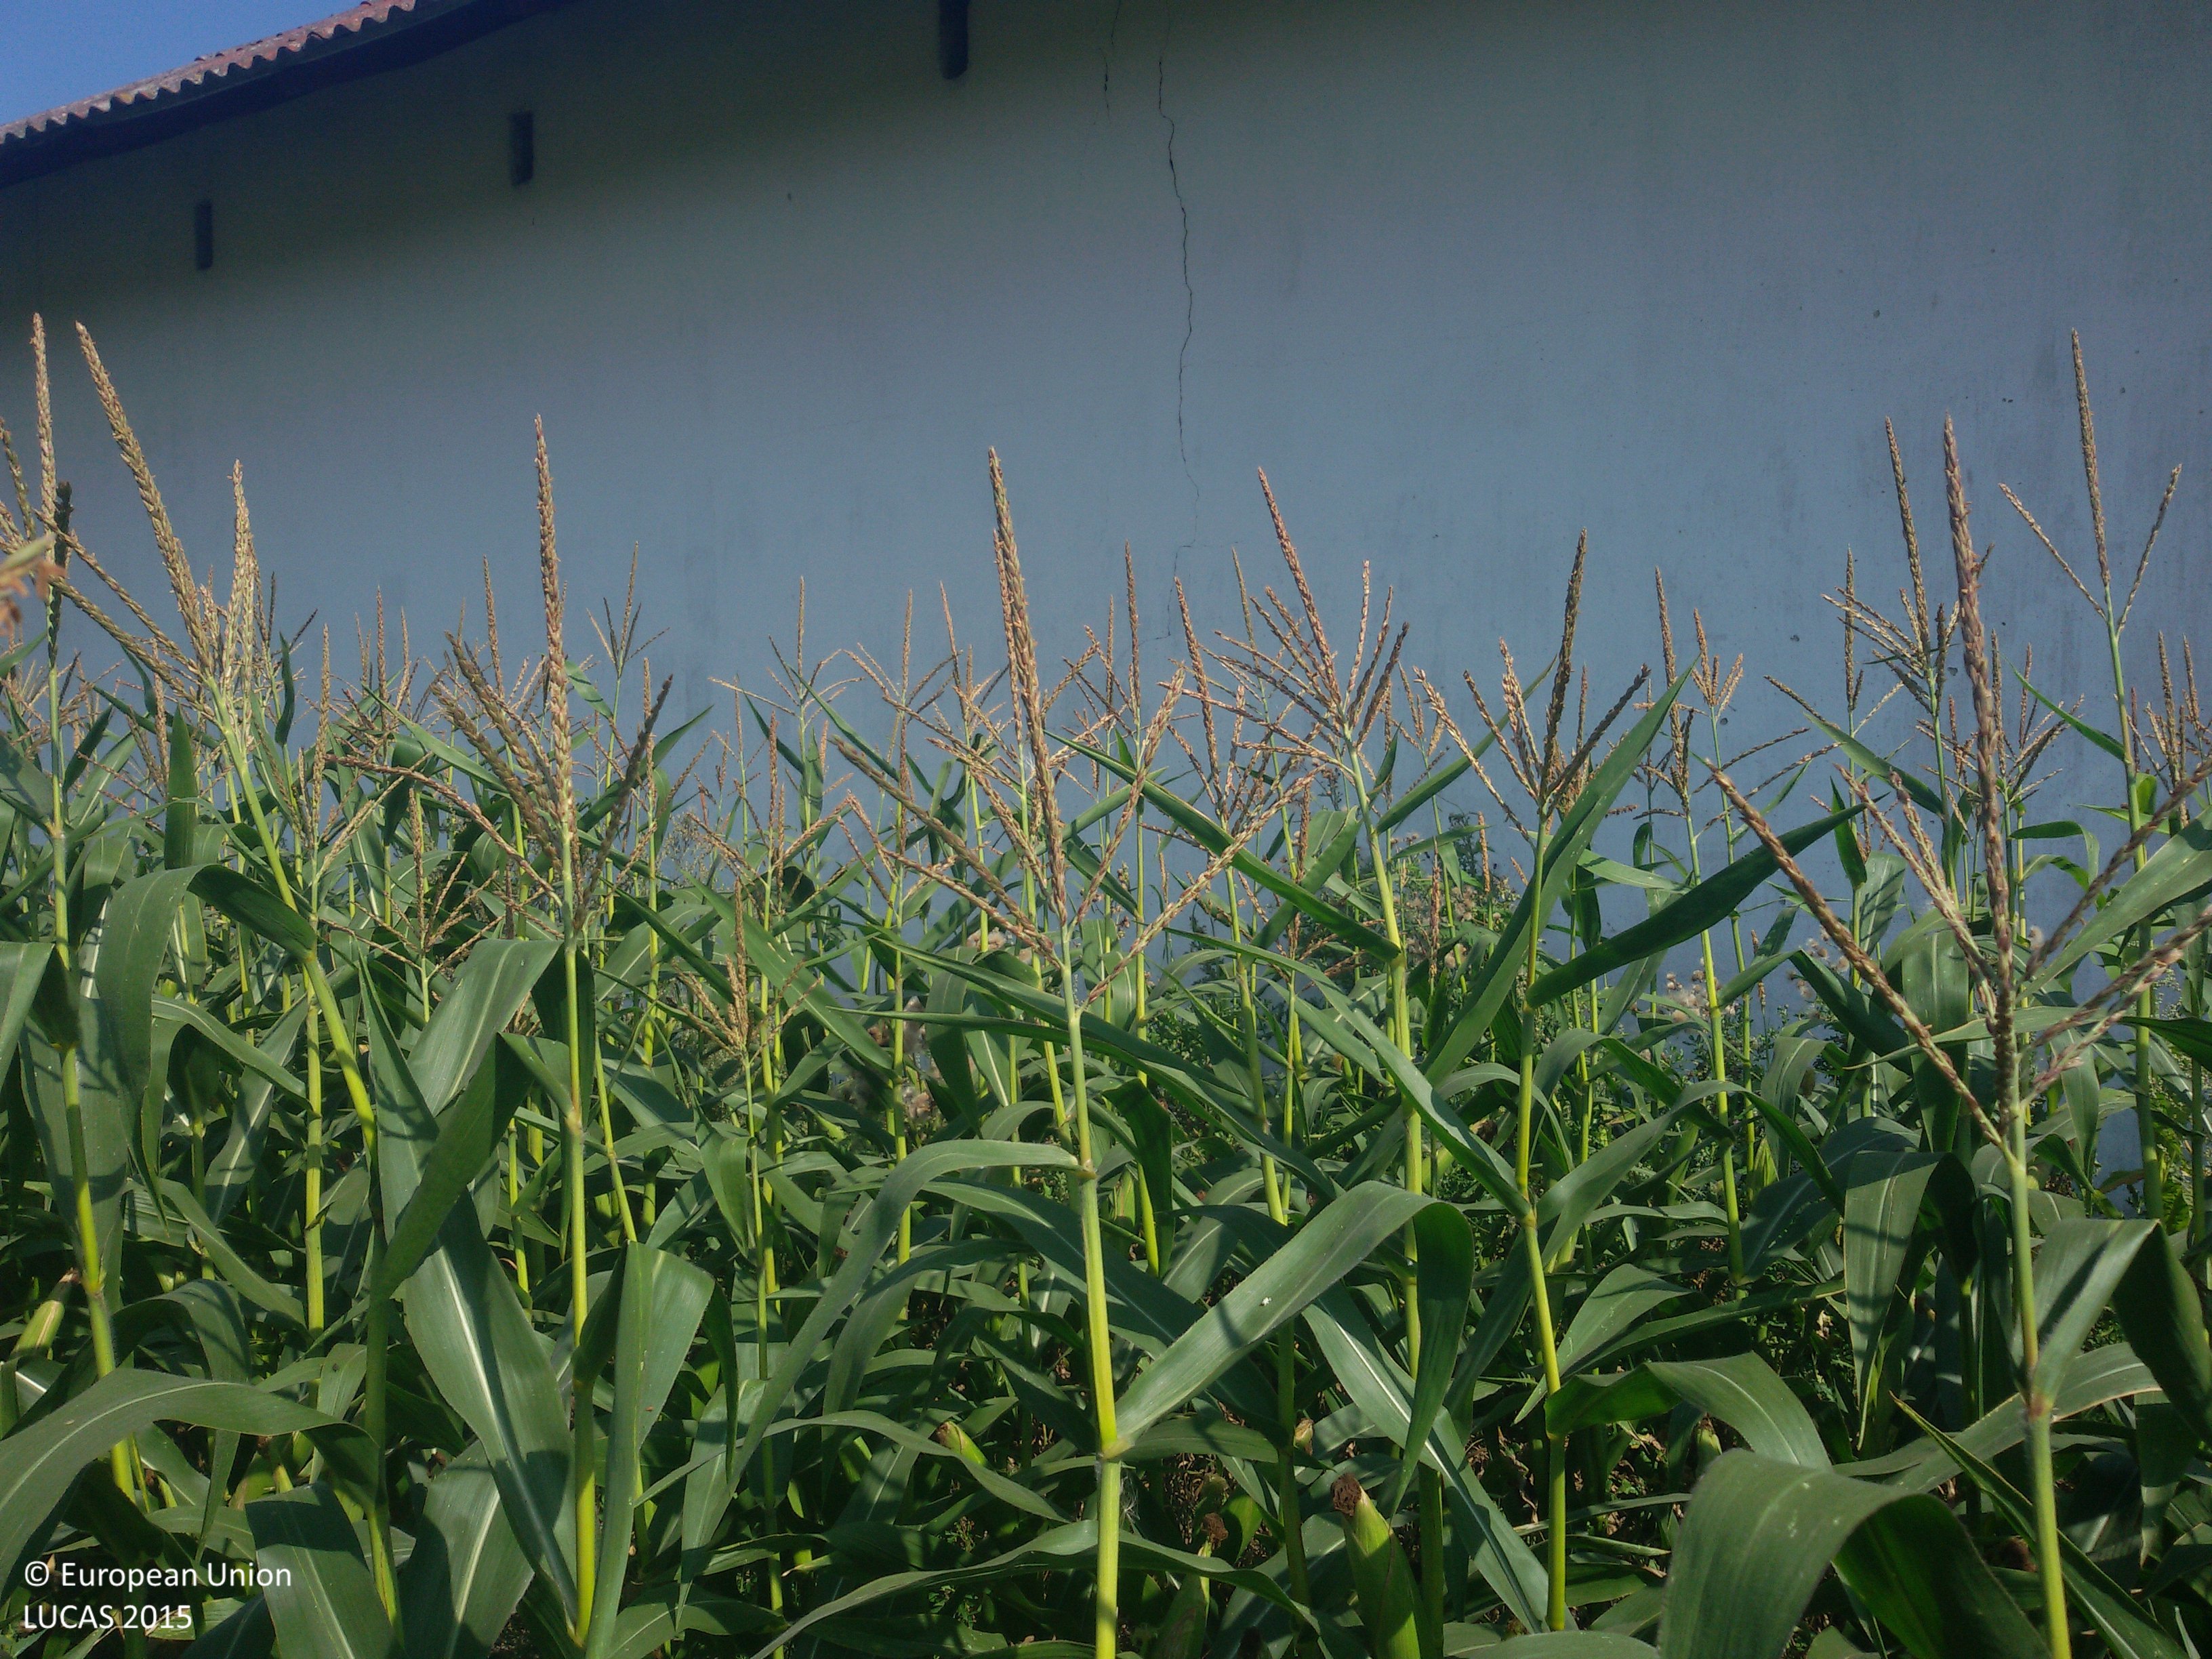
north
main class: Cropland
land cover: Maize
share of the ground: > 75 %
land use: Agriculture (excluding fallow land and kitchen gardens)
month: August
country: PL
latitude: 52.6929
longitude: 20.0496
